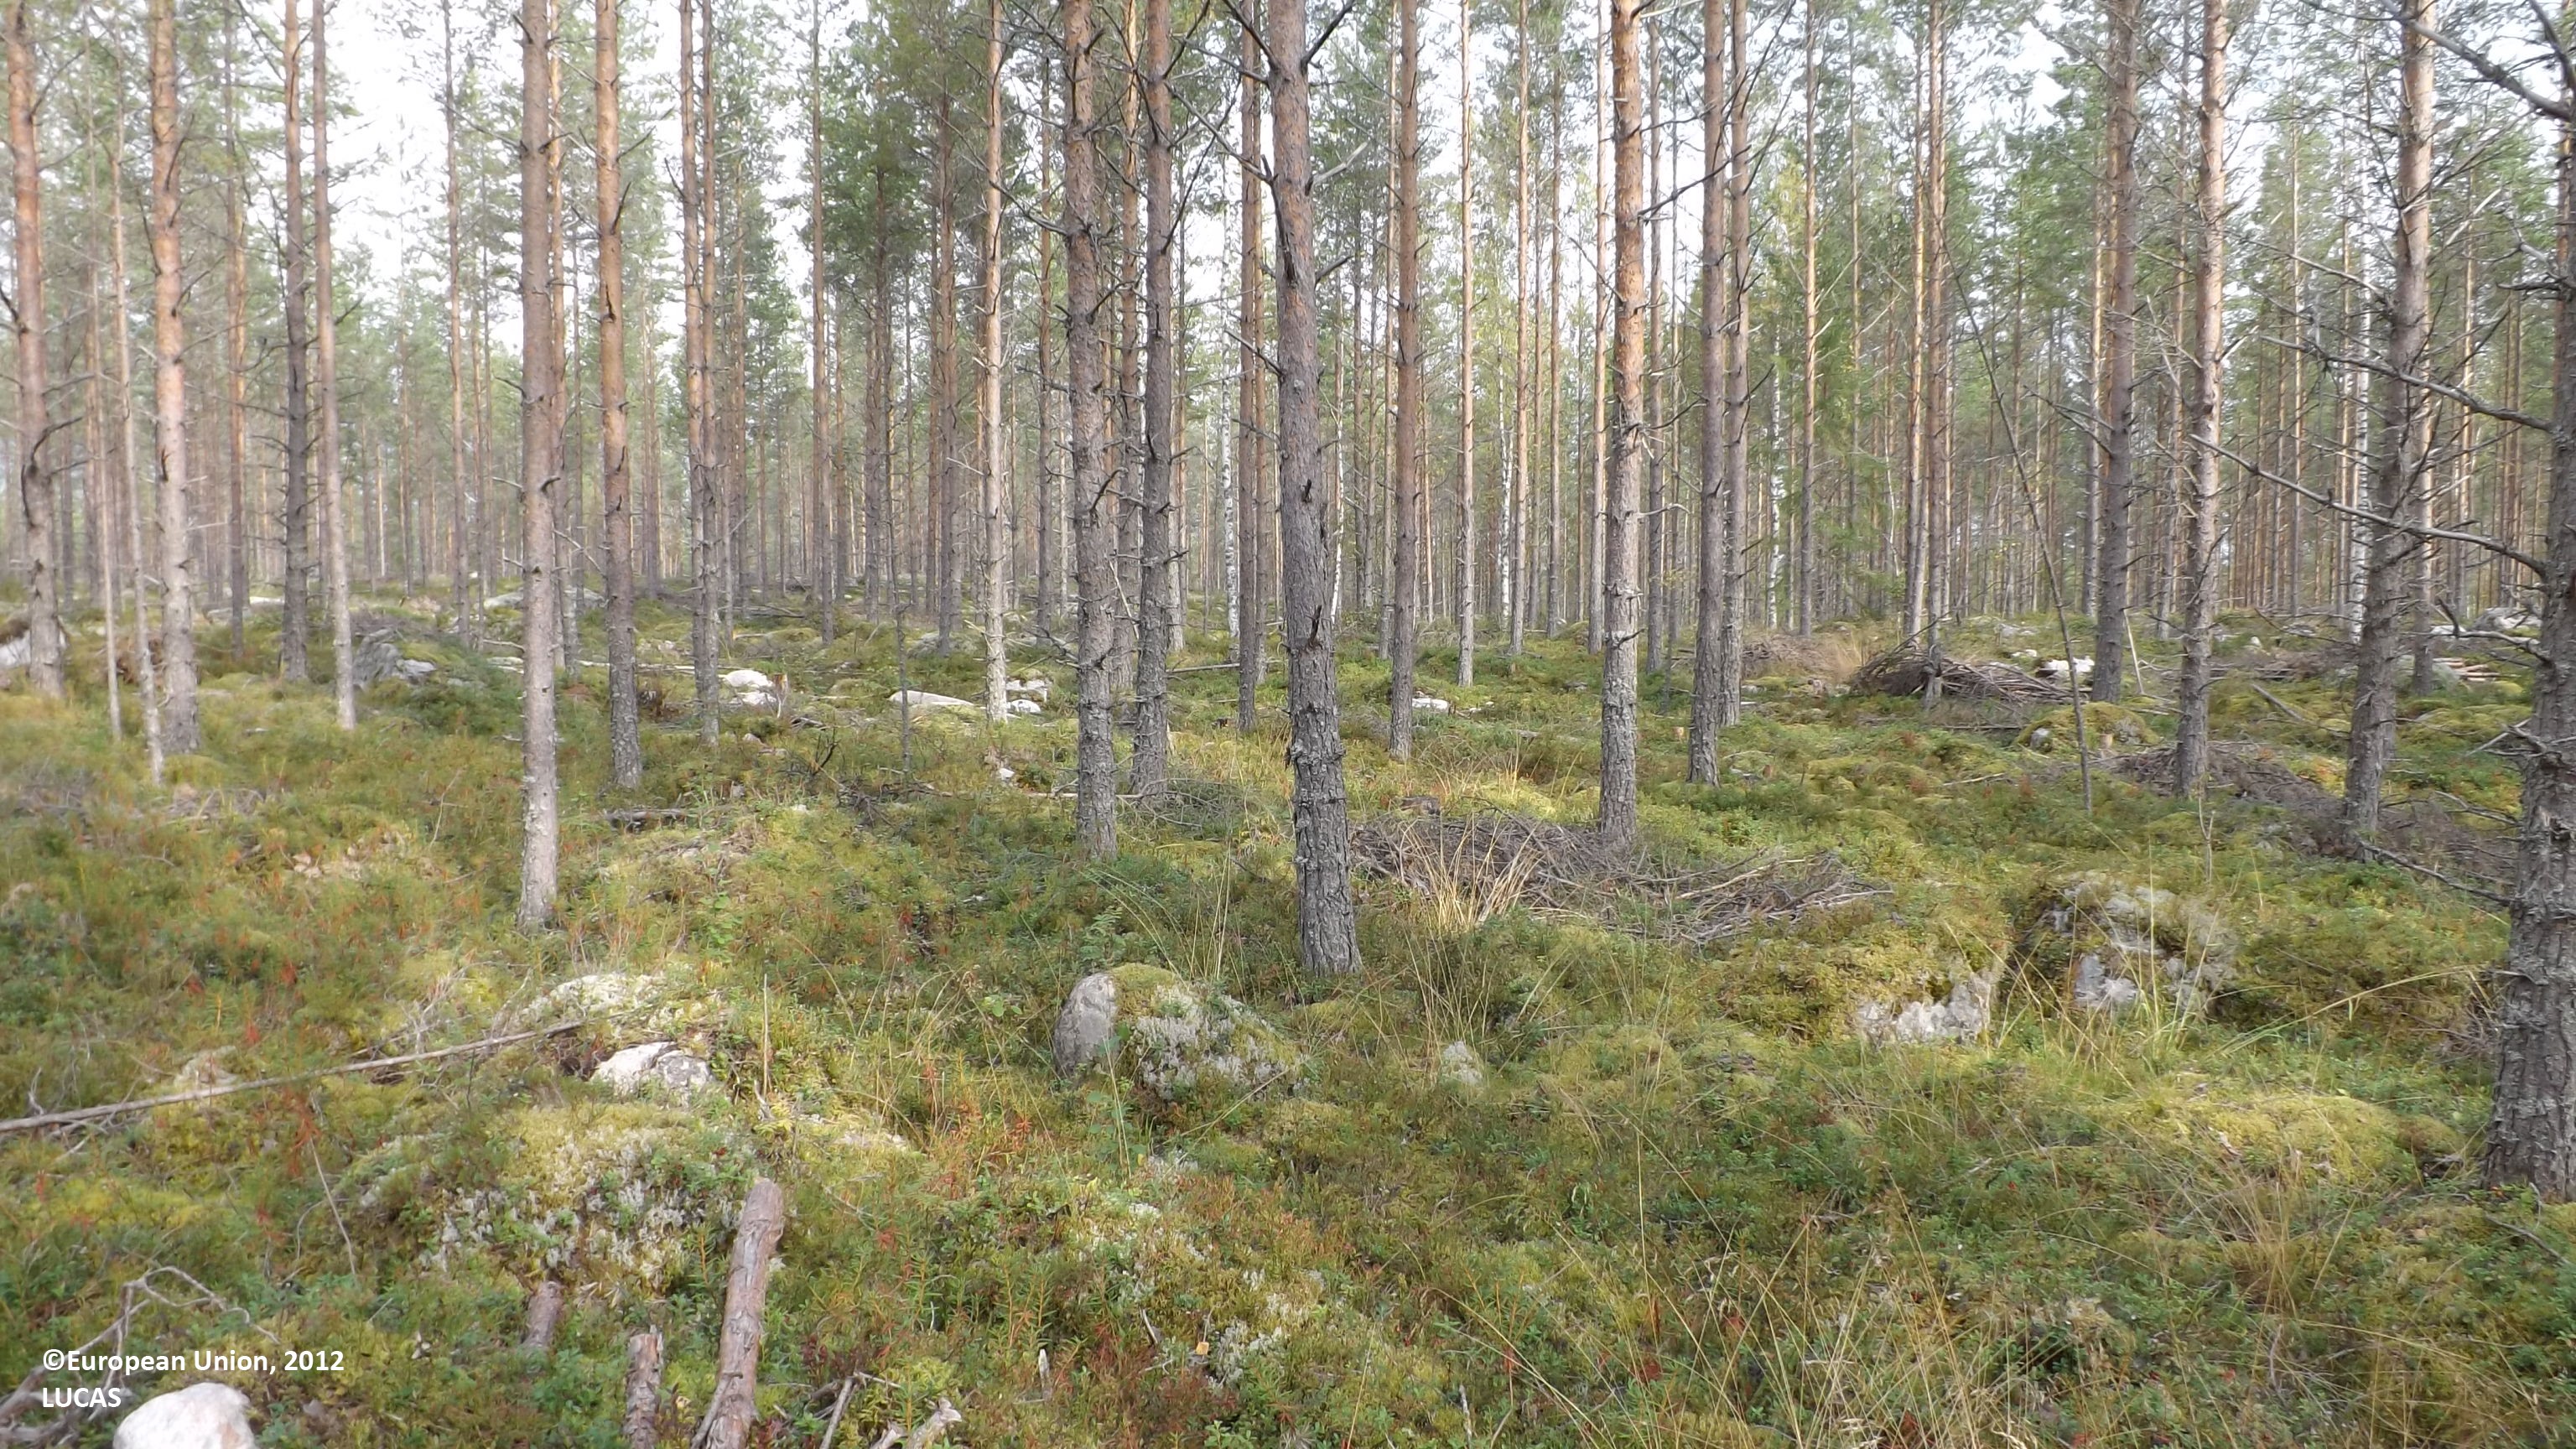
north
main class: Woodland
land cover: Pine dominated coniferous woodland
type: boreal forest
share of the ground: 25 - 50 %
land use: Forestry
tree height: > 5 m
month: August
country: FI
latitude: 63.7595
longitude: 23.7470
